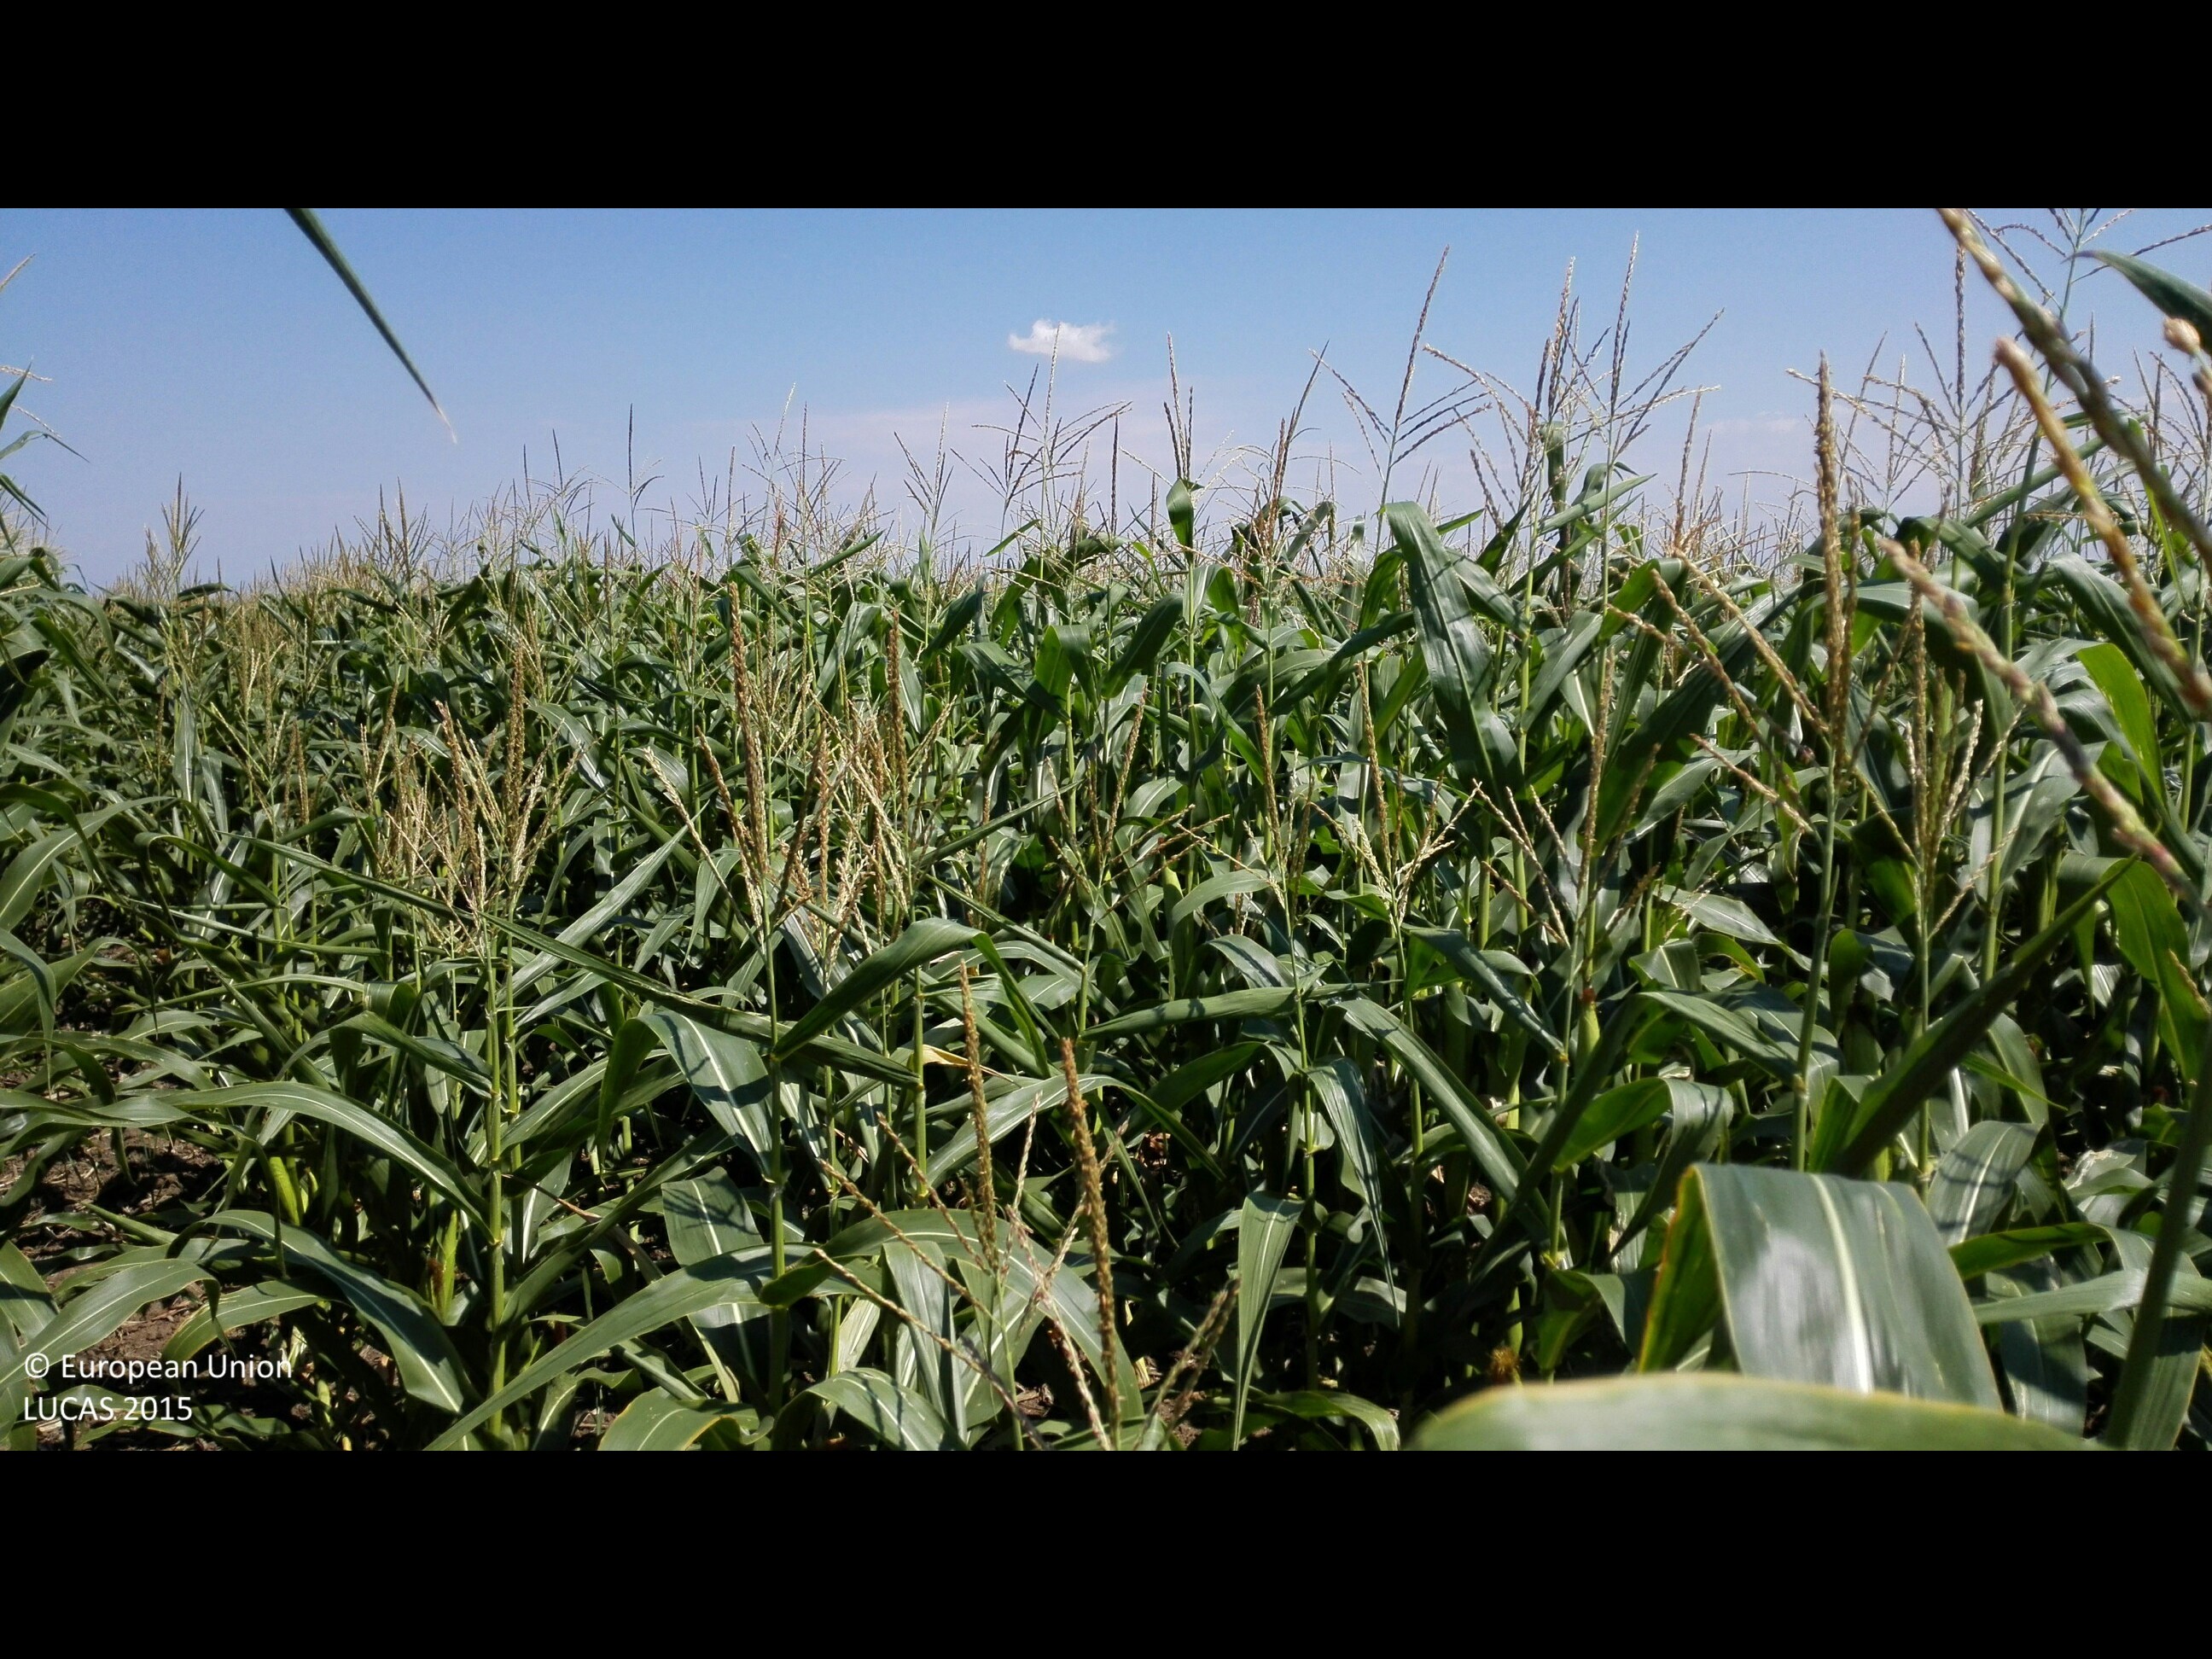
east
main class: Cropland
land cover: Maize
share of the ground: > 75 %
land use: Agriculture (excluding fallow land and kitchen gardens)
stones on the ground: < 10 %
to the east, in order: Maize; Tracks; Grass margins; Ditches and canals; Lucerne
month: July
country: HU
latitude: 47.2249
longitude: 21.2775
